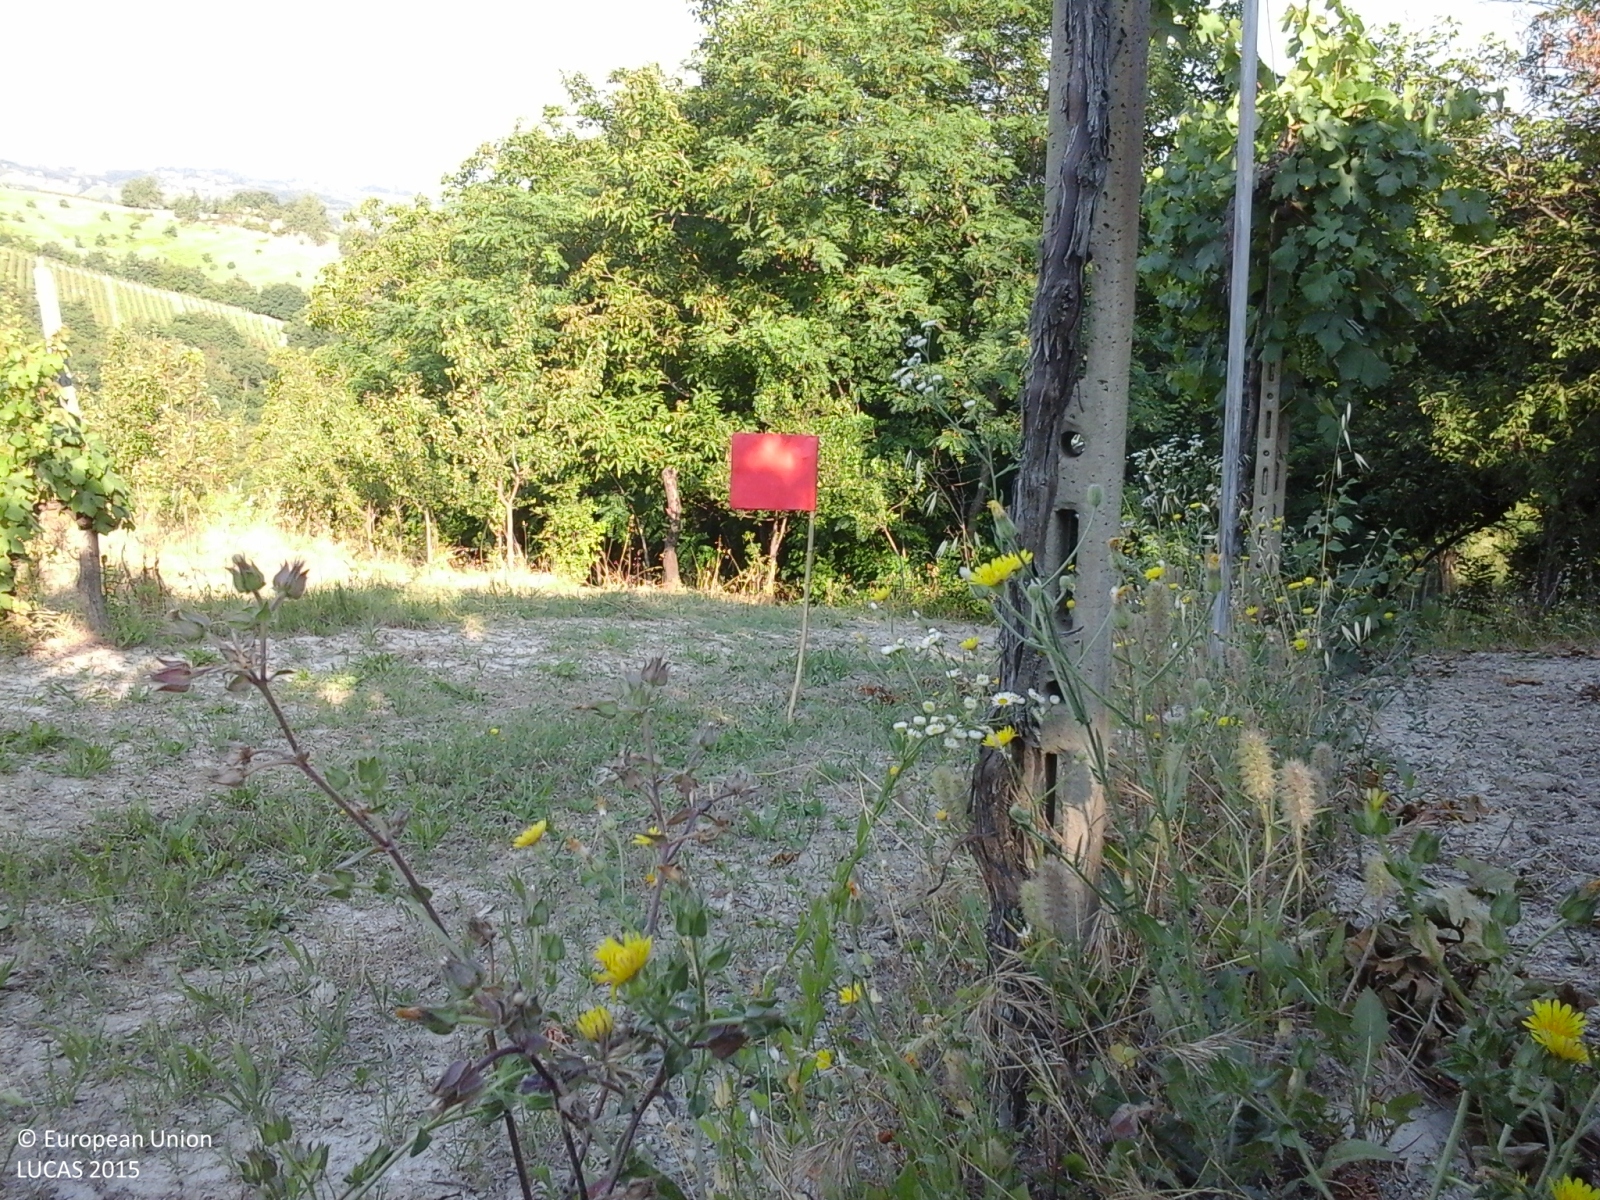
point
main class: Cropland
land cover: Vineyards
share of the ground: 50 - 75 %
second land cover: Grassland without tree/shrub cover
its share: 50 - 75 %
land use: Agriculture (excluding fallow land and kitchen gardens)
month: June
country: IT
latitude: 44.6494
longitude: 8.7291
